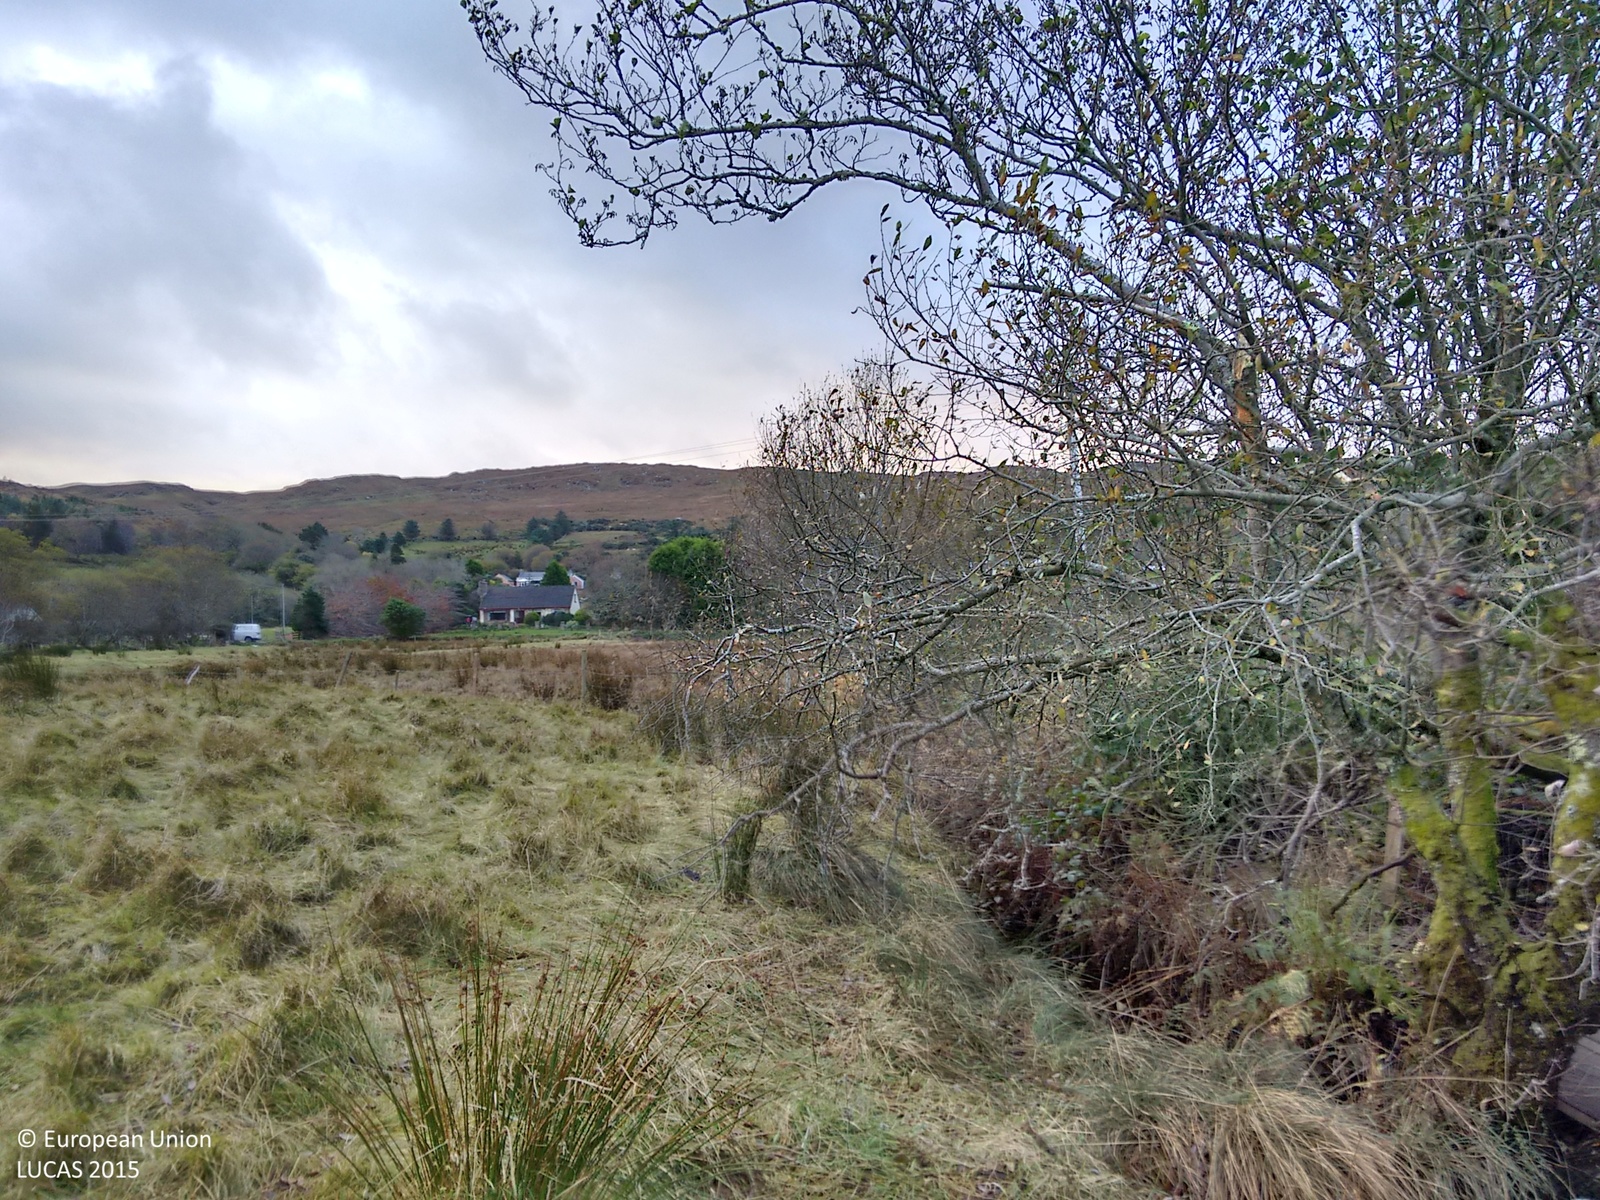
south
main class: Shrubland
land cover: Shrubland without tree cover
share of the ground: > 75 %
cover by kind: shrubs 70 %, herbaceous plants 30 %
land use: Agriculture (excluding fallow land and kitchen gardens)
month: November
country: IE
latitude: 54.7848
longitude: -8.2660
